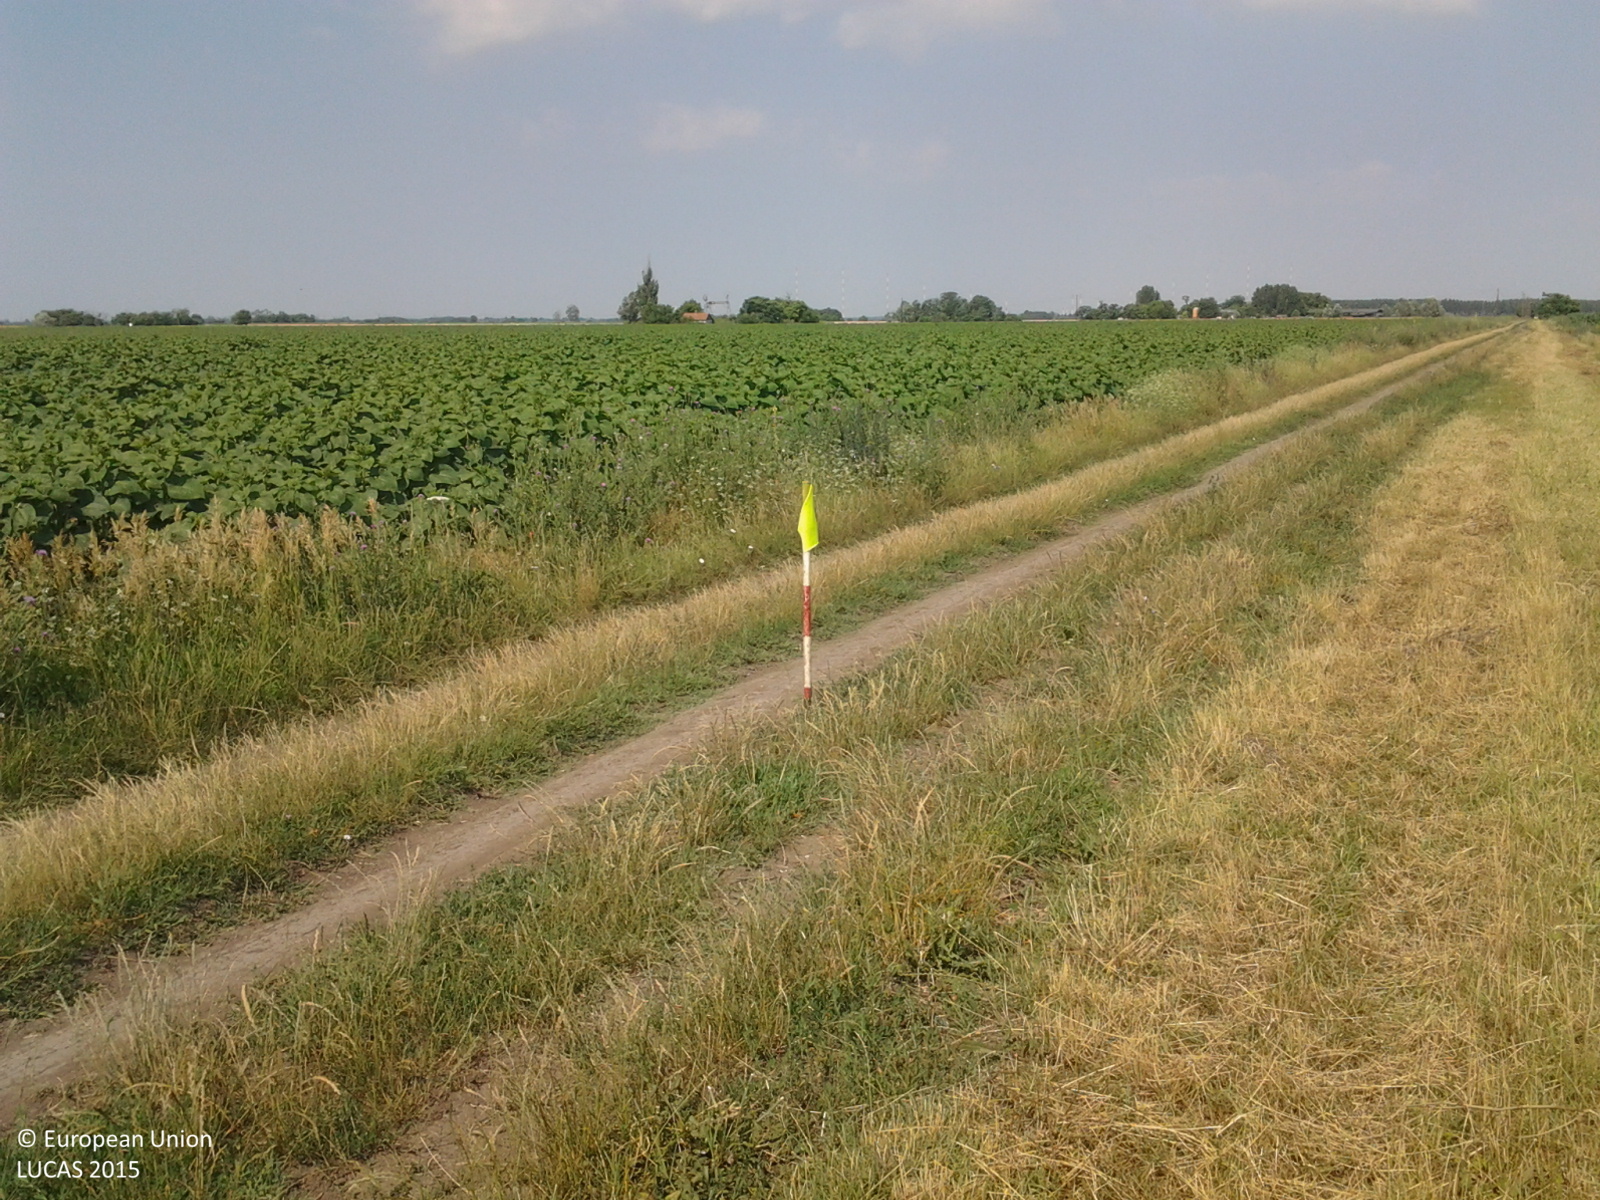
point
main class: Grassland
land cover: Grassland without tree/shrub cover
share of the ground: > 75 %
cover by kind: herbaceous plants 100 %
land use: Agriculture (excluding fallow land and kitchen gardens)
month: July
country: HU
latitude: 47.5593
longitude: 19.8999
